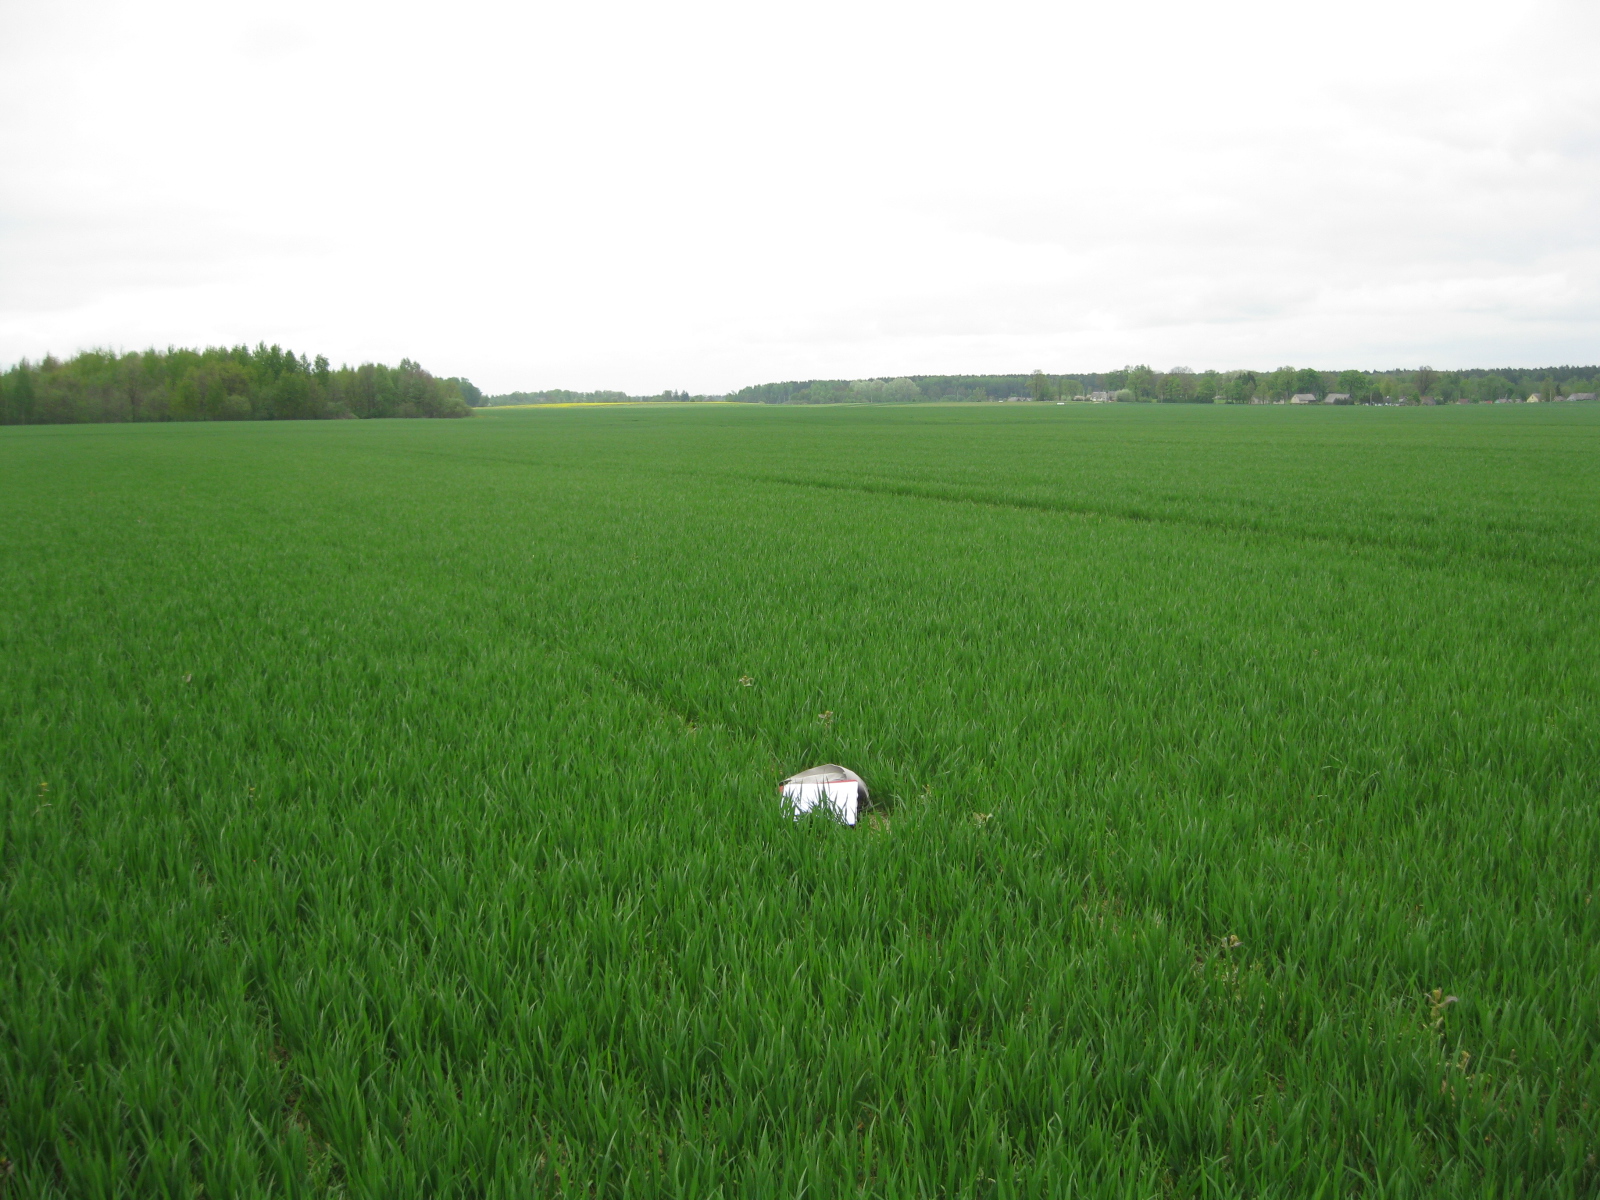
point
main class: Cropland
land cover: Common wheat
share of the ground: > 75 %
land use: Agriculture (excluding fallow land and kitchen gardens)
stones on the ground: < 10 %
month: May
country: LT
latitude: 56.0079
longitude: 24.4182
